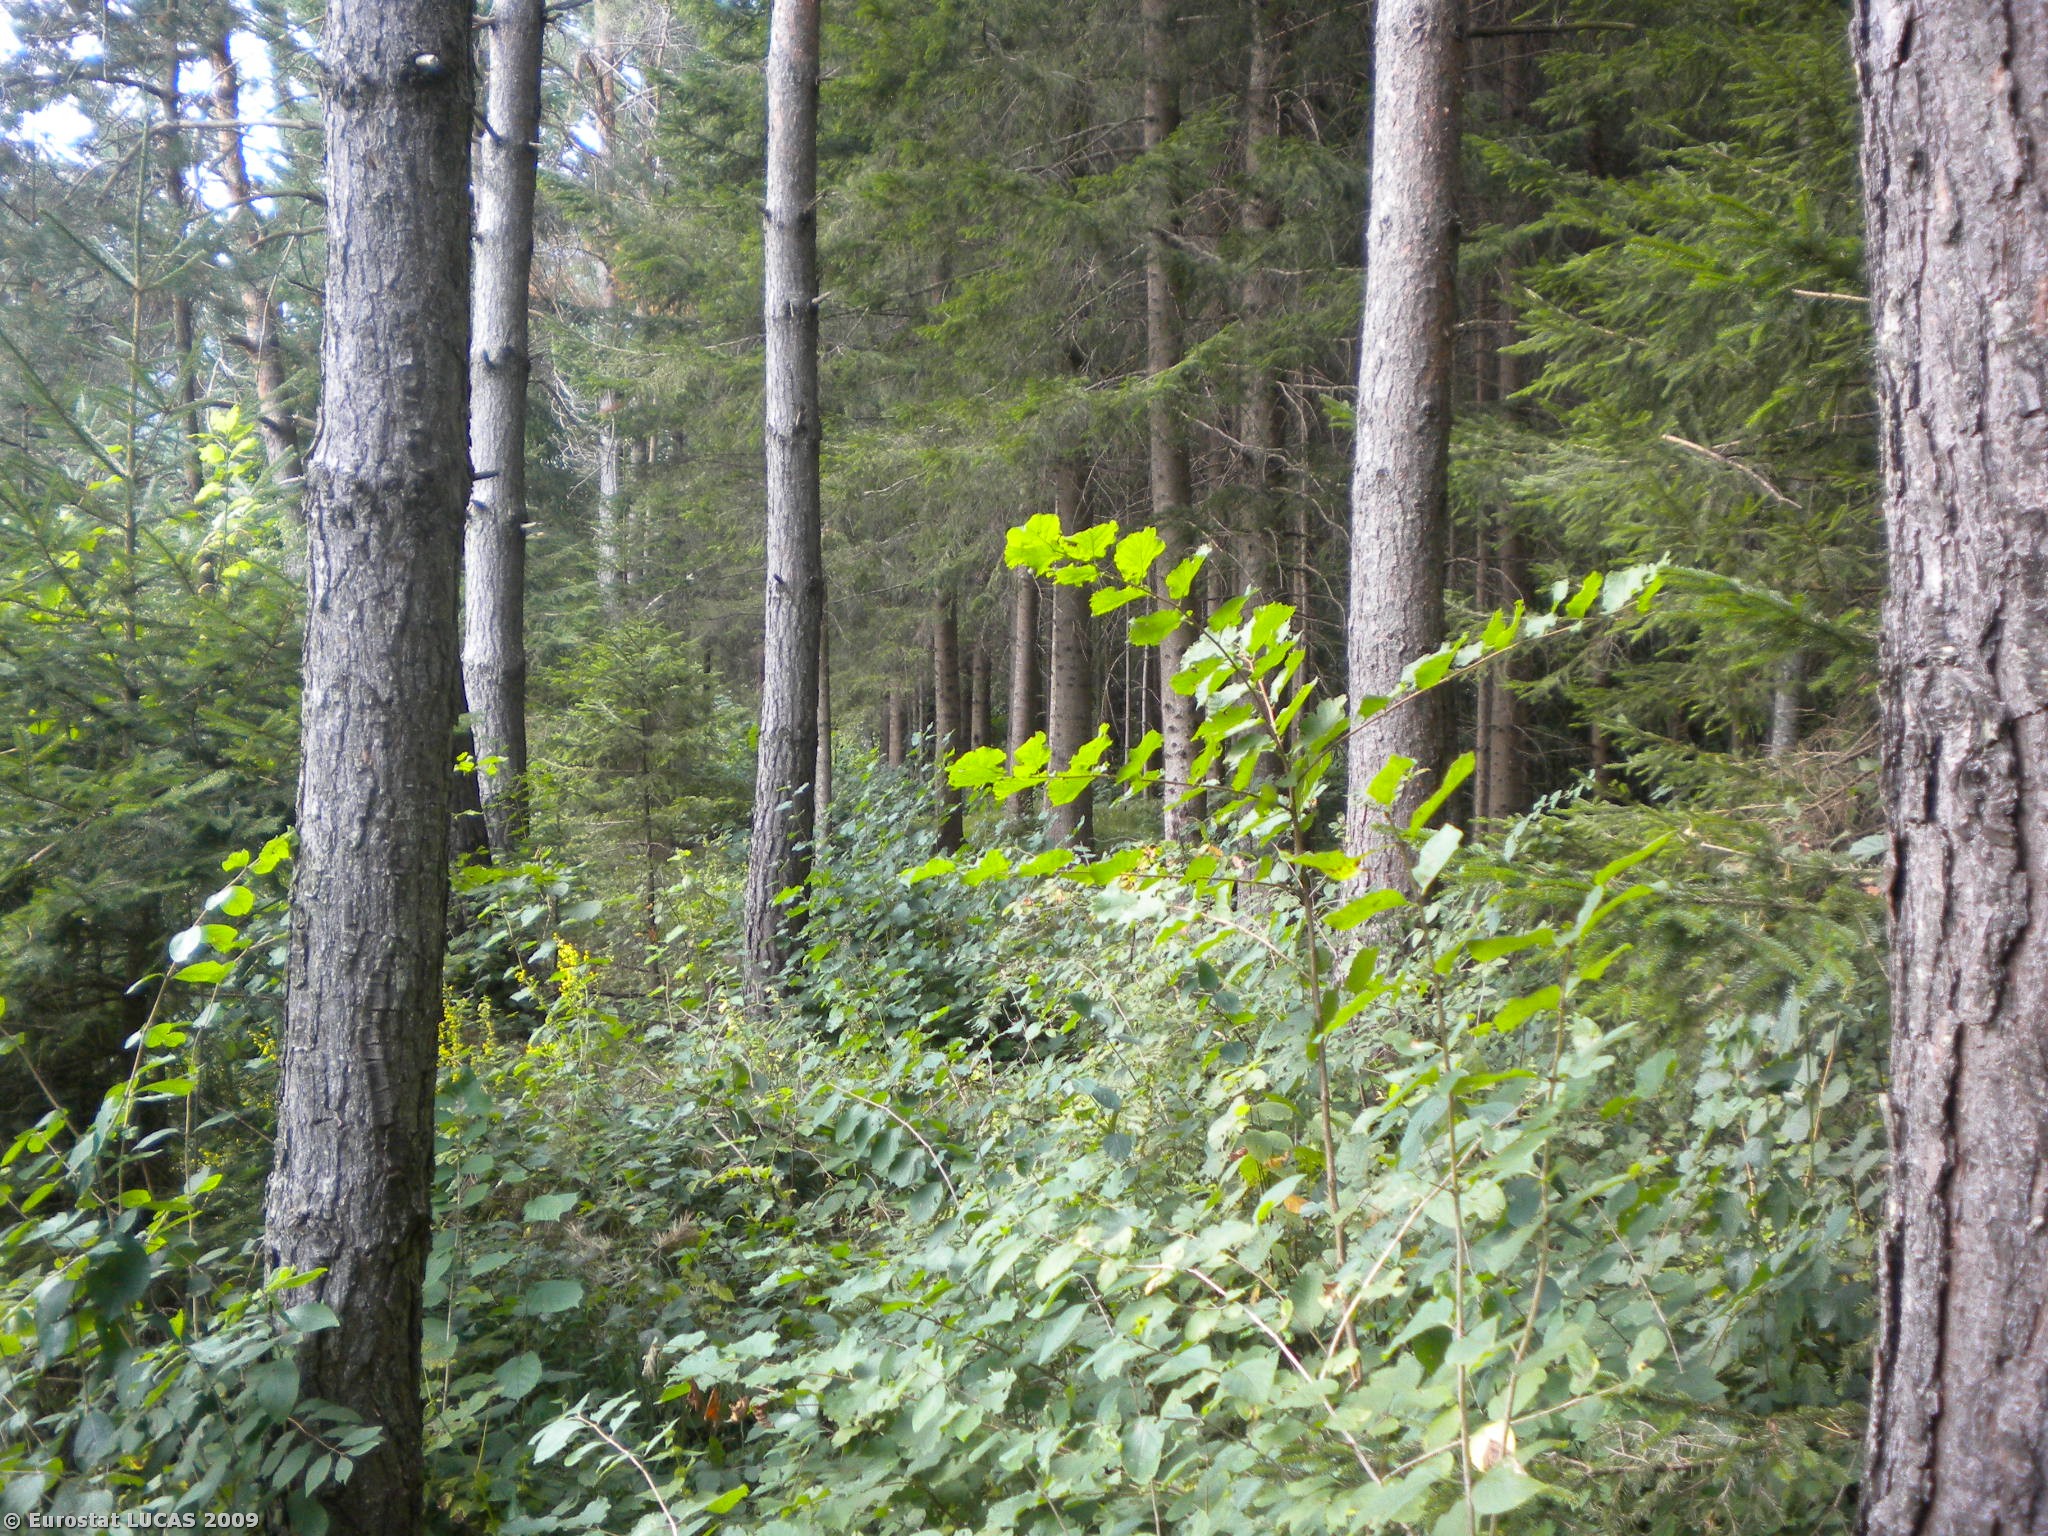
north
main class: Woodland
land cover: Coniferous woodland
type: alpine coniferous forest
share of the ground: > 75 %
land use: Forestry
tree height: > 5 m
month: August
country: AT
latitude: 46.7418
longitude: 12.9946
